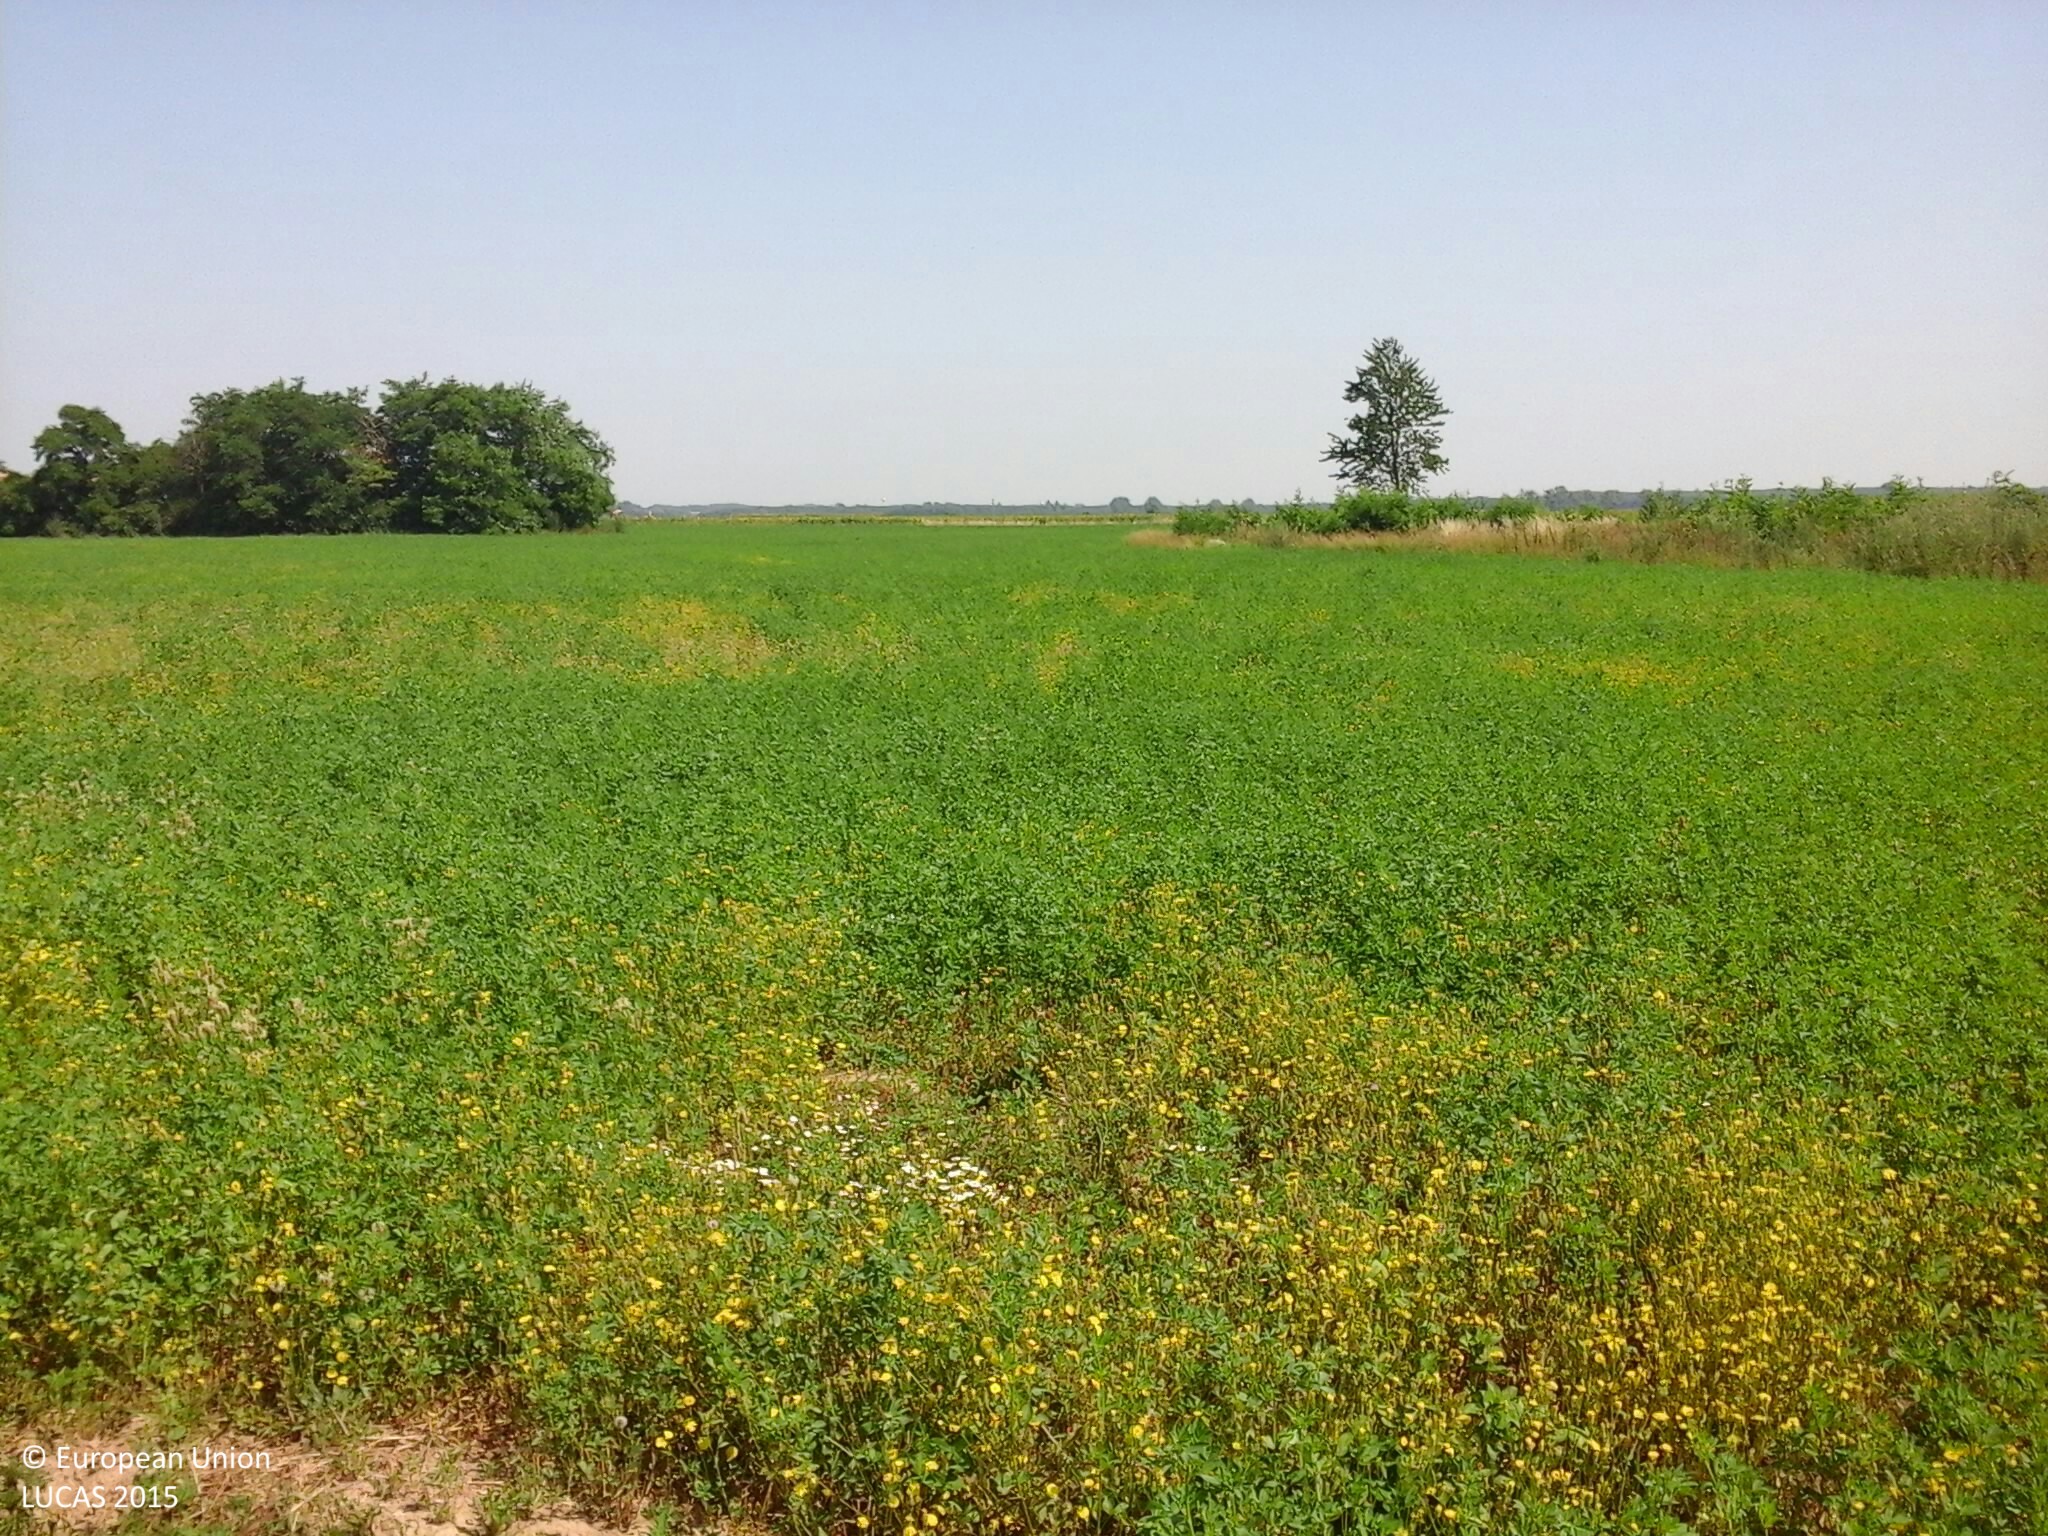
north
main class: Cropland
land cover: Lucerne
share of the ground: > 75 %
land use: Agriculture (excluding fallow land and kitchen gardens)
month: July
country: HU
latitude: 47.2379
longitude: 17.3379
